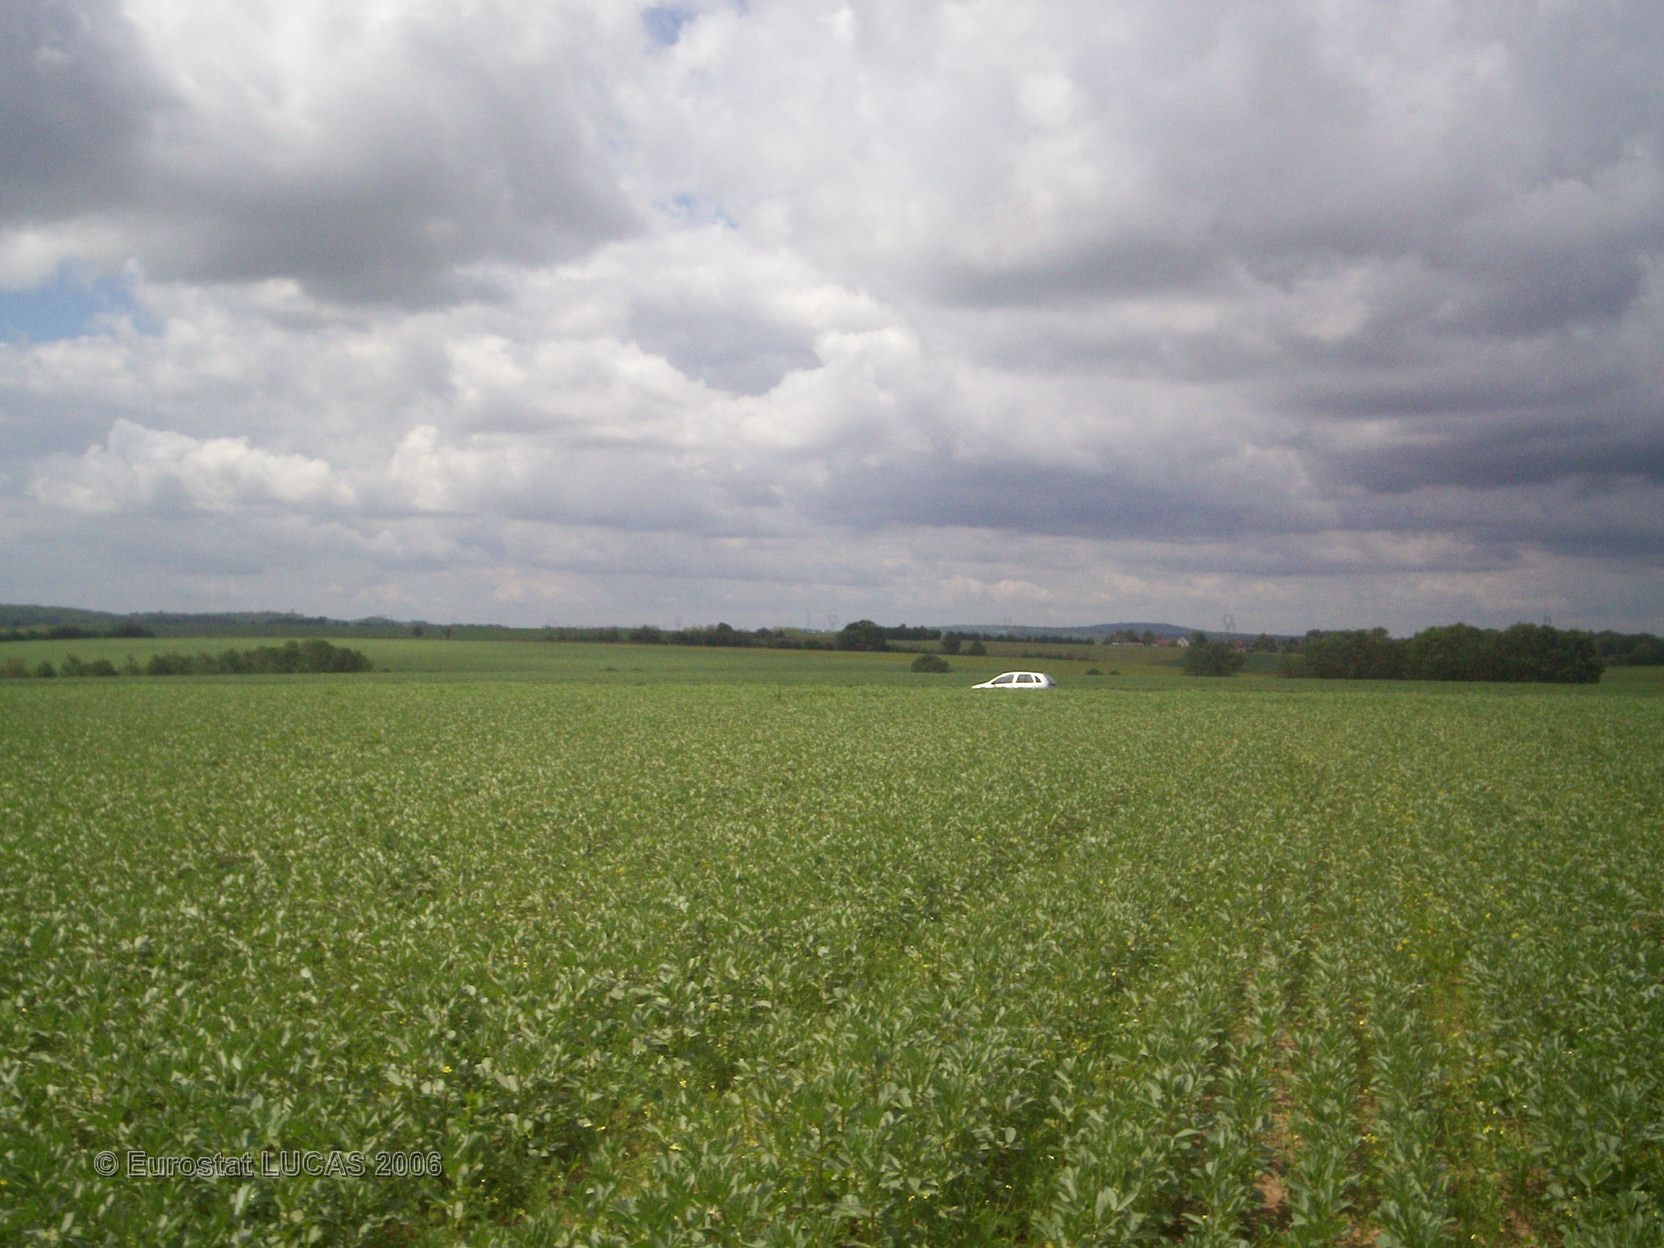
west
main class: Cropland
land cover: Dry pulses
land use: Agriculture (excluding fallow land and kitchen gardens)
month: May
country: FR
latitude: 49.0845
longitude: 2.7191
